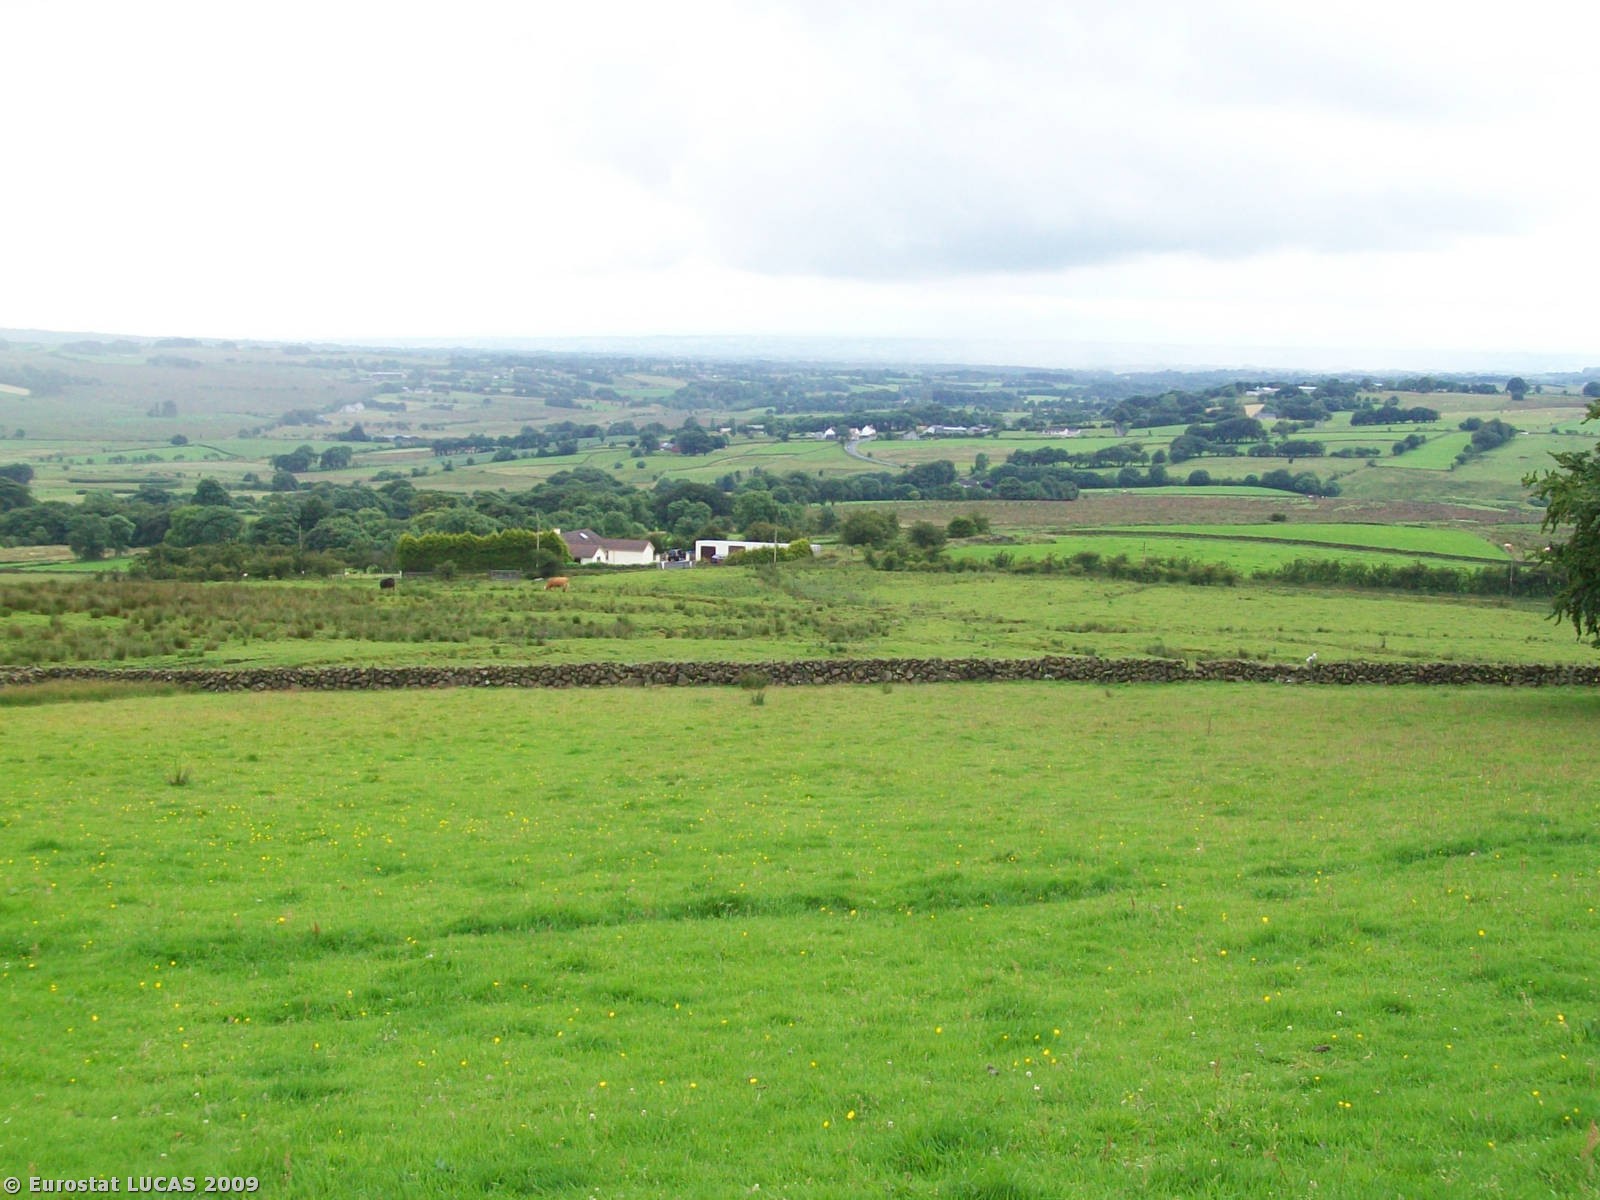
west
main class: Grassland
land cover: Grassland without tree/shrub cover
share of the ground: > 75 %
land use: Agriculture (excluding fallow land and kitchen gardens)
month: July
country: GB
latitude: 54.8343
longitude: -6.0688
